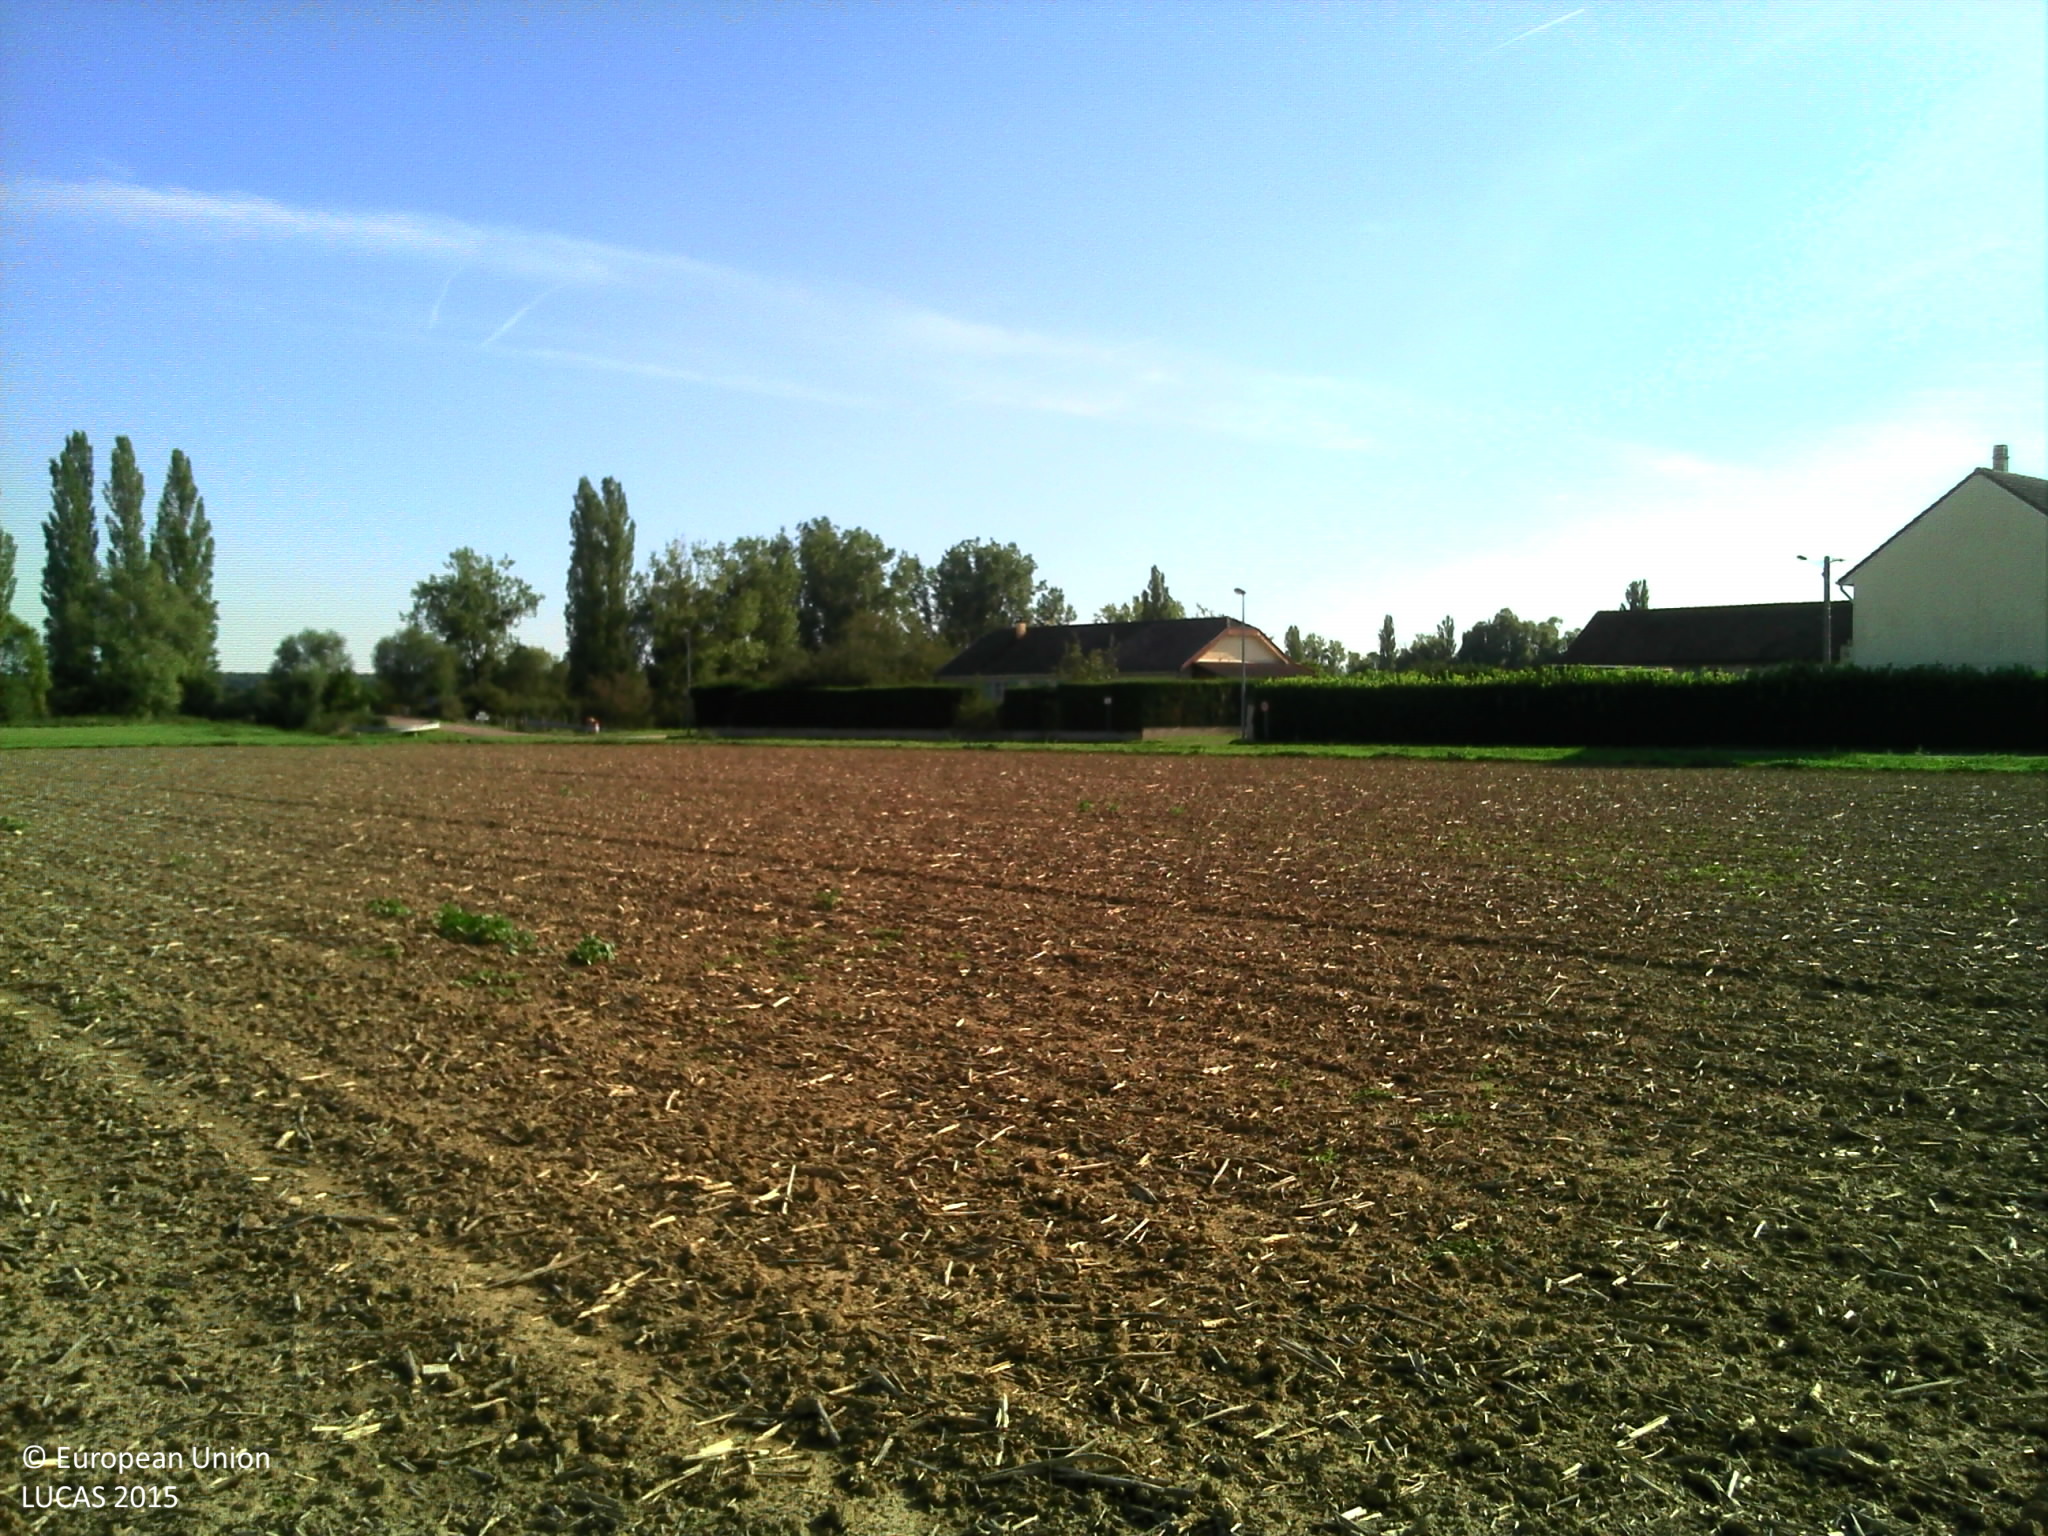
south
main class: Cropland
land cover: Rape and turnip rape
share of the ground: < 10 %
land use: Agriculture (excluding fallow land and kitchen gardens)
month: September
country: FR
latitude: 46.9279
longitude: 4.7869
